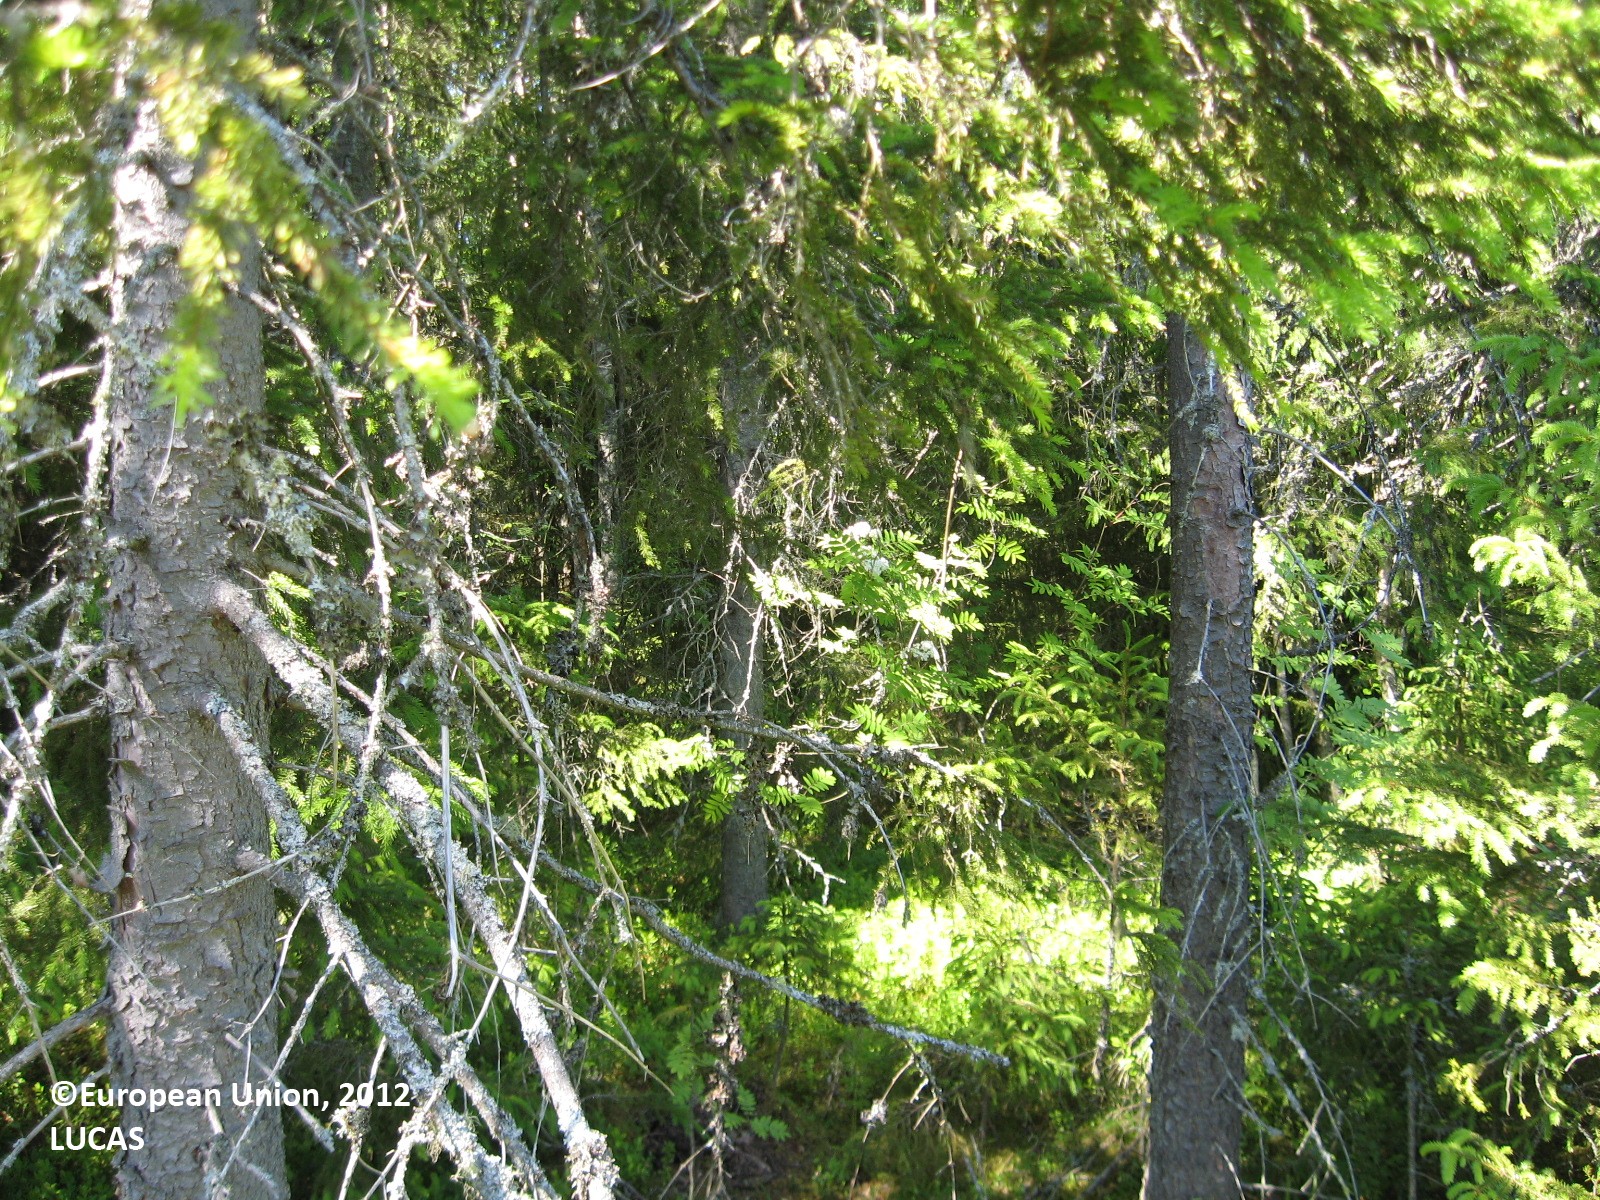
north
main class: Woodland
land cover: Spruce dominated mixed woodland
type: boreal forest
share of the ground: > 75 %
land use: Forestry
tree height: > 5 m
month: June
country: FI
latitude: 62.9913
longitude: 21.7468
